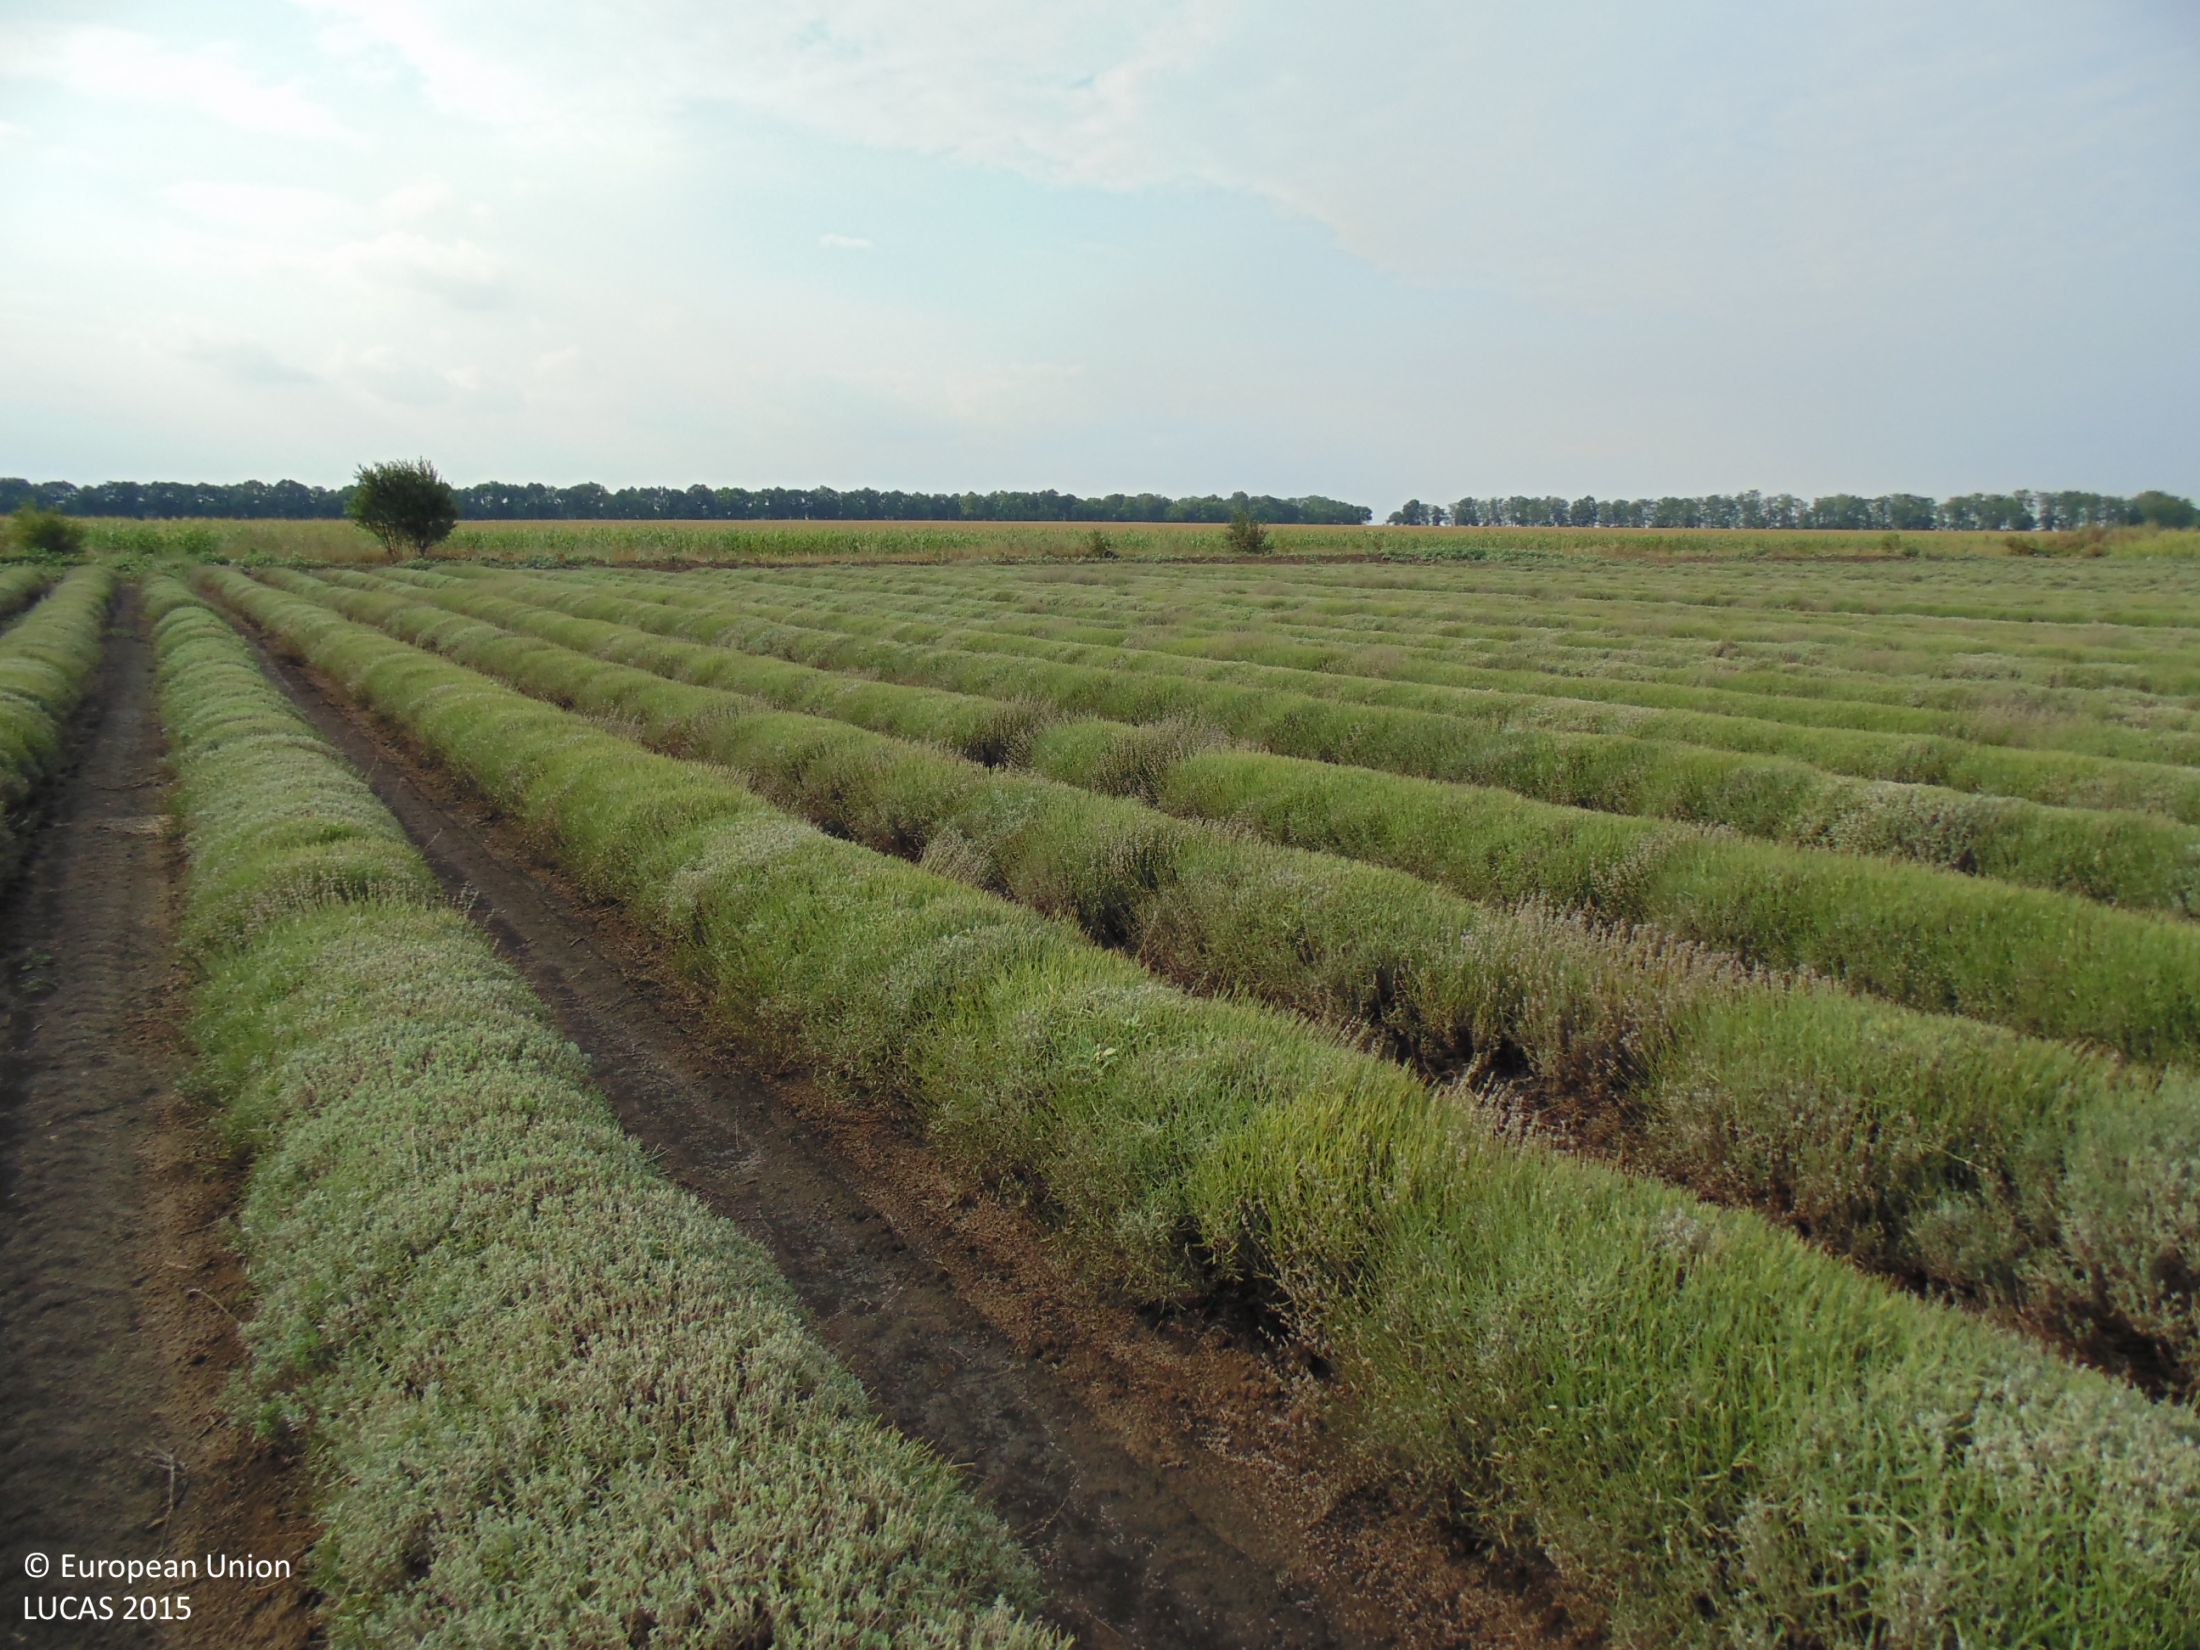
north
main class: Cropland
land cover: Other non-permanent industrial crops
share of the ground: > 75 %
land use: Agriculture (excluding fallow land and kitchen gardens)
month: August
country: BG
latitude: 43.7703
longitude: 28.0266
